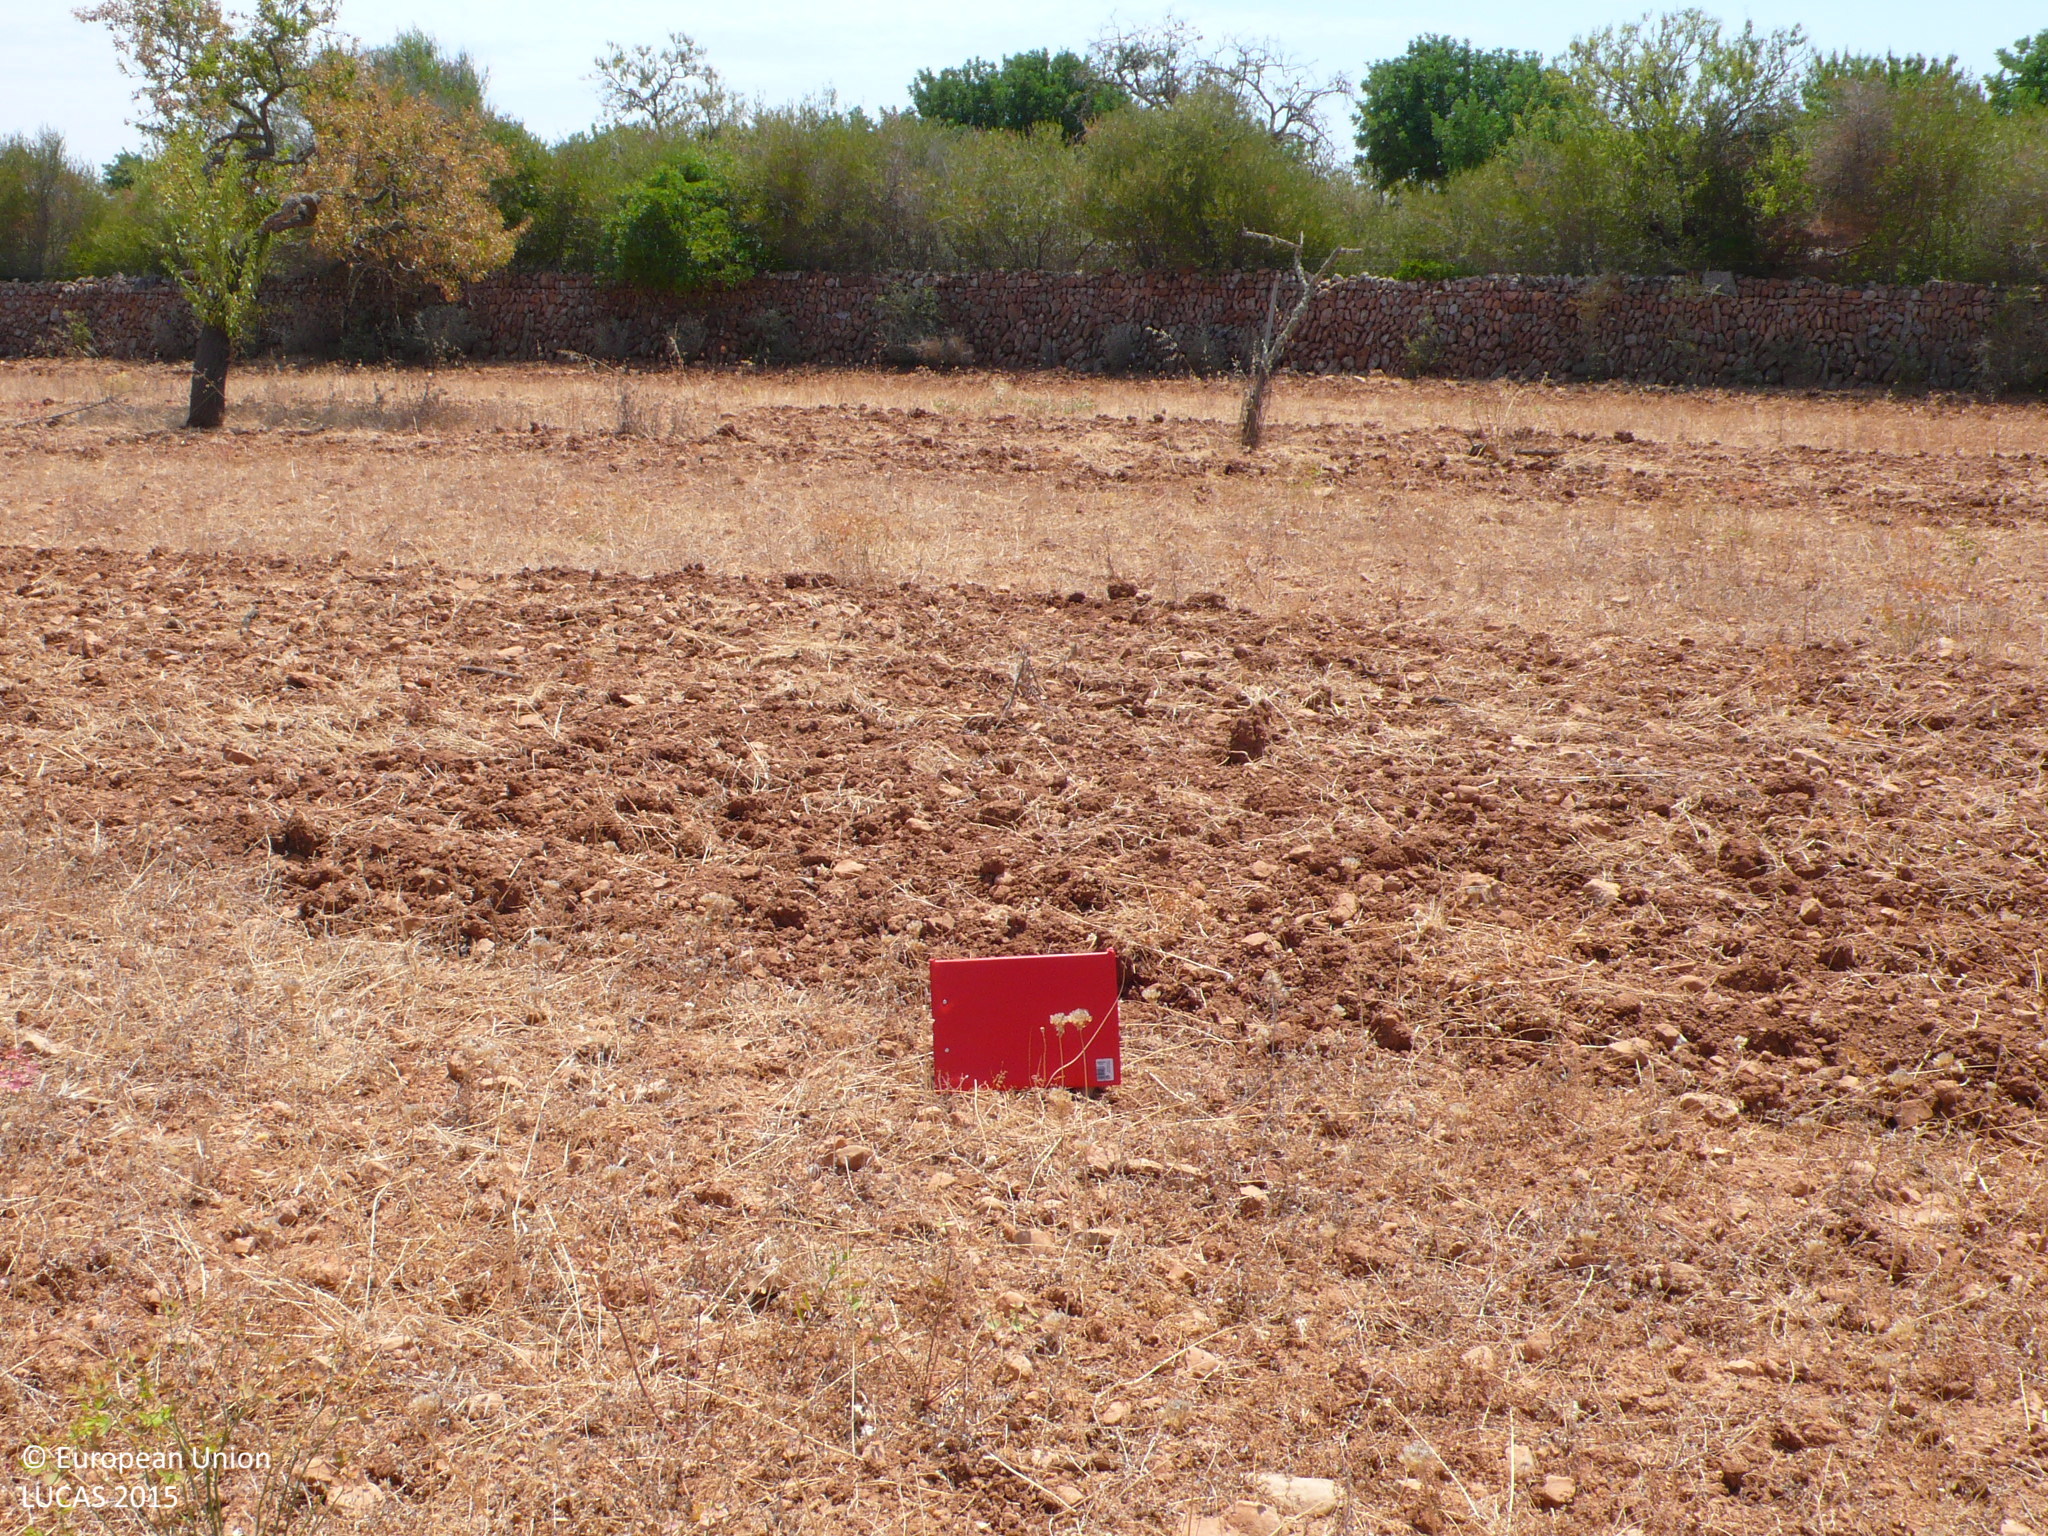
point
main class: Cropland
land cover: Nuts trees
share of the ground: 10 - 25 %
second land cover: Spontaneously vegetated surfaces
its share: 10 - 25 %
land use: Agriculture (excluding fallow land and kitchen gardens)
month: July
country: ES
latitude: 39.4044
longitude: 2.8199
